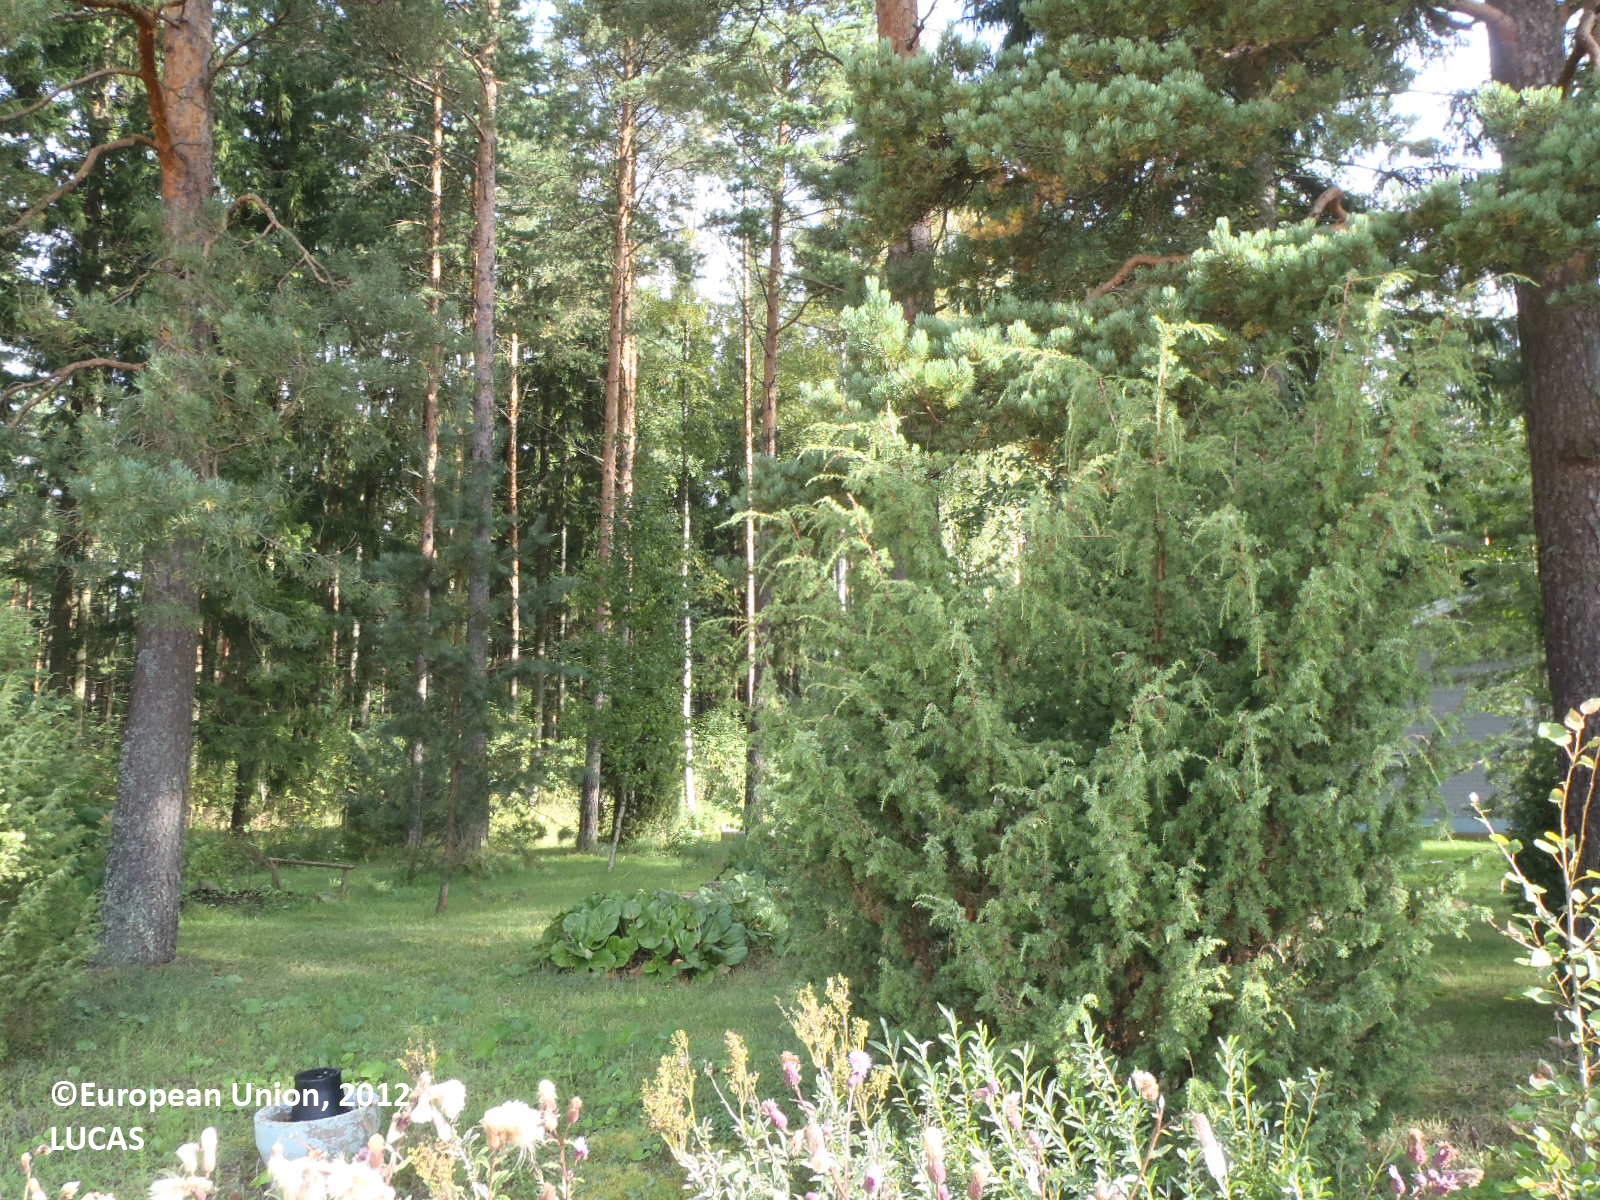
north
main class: Cropland
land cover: Barley
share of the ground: > 75 %
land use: Agriculture (excluding fallow land and kitchen gardens)
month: August
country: FI
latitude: 60.6262
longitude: 22.2934
